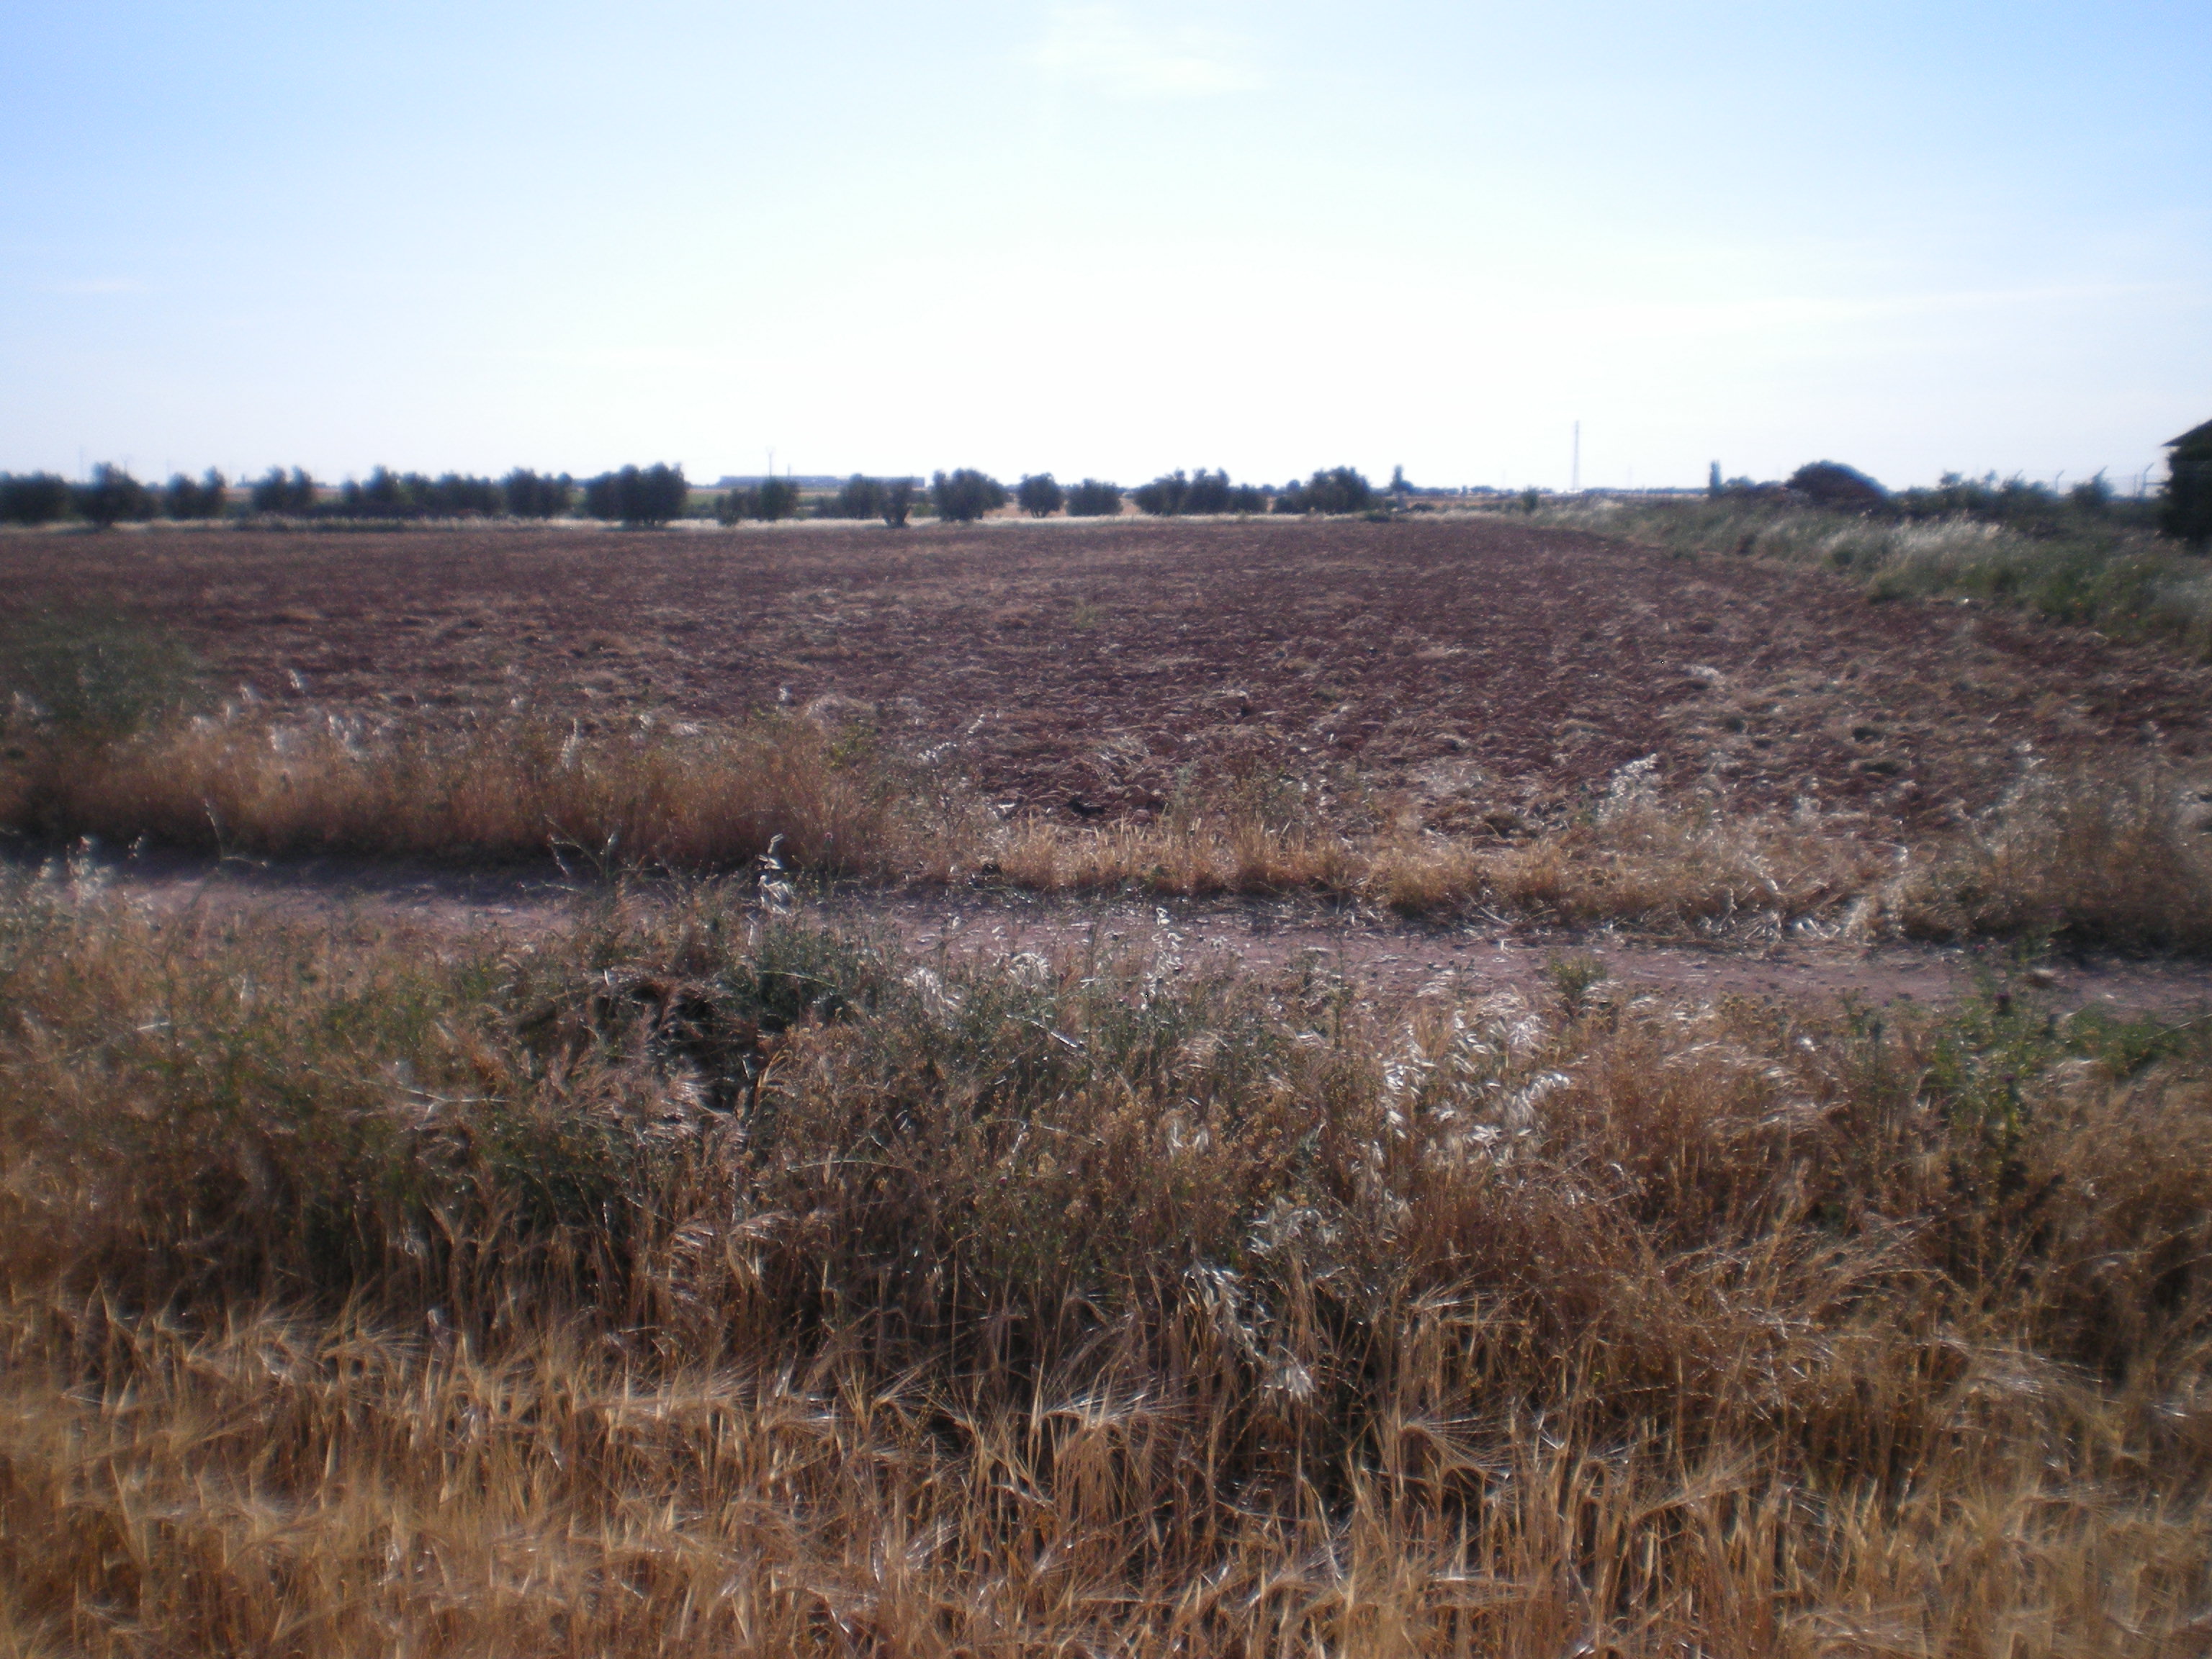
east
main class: Cropland
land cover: Barley
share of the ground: > 75 %
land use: Agriculture (excluding fallow land and kitchen gardens)
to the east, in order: Barley; Grass margins; Tracks; Grass margins; Other bare soil; Grass margins; Dry stone walls; Grass margins; Olive groves
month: May
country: ES
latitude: 39.0384
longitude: -3.6153
